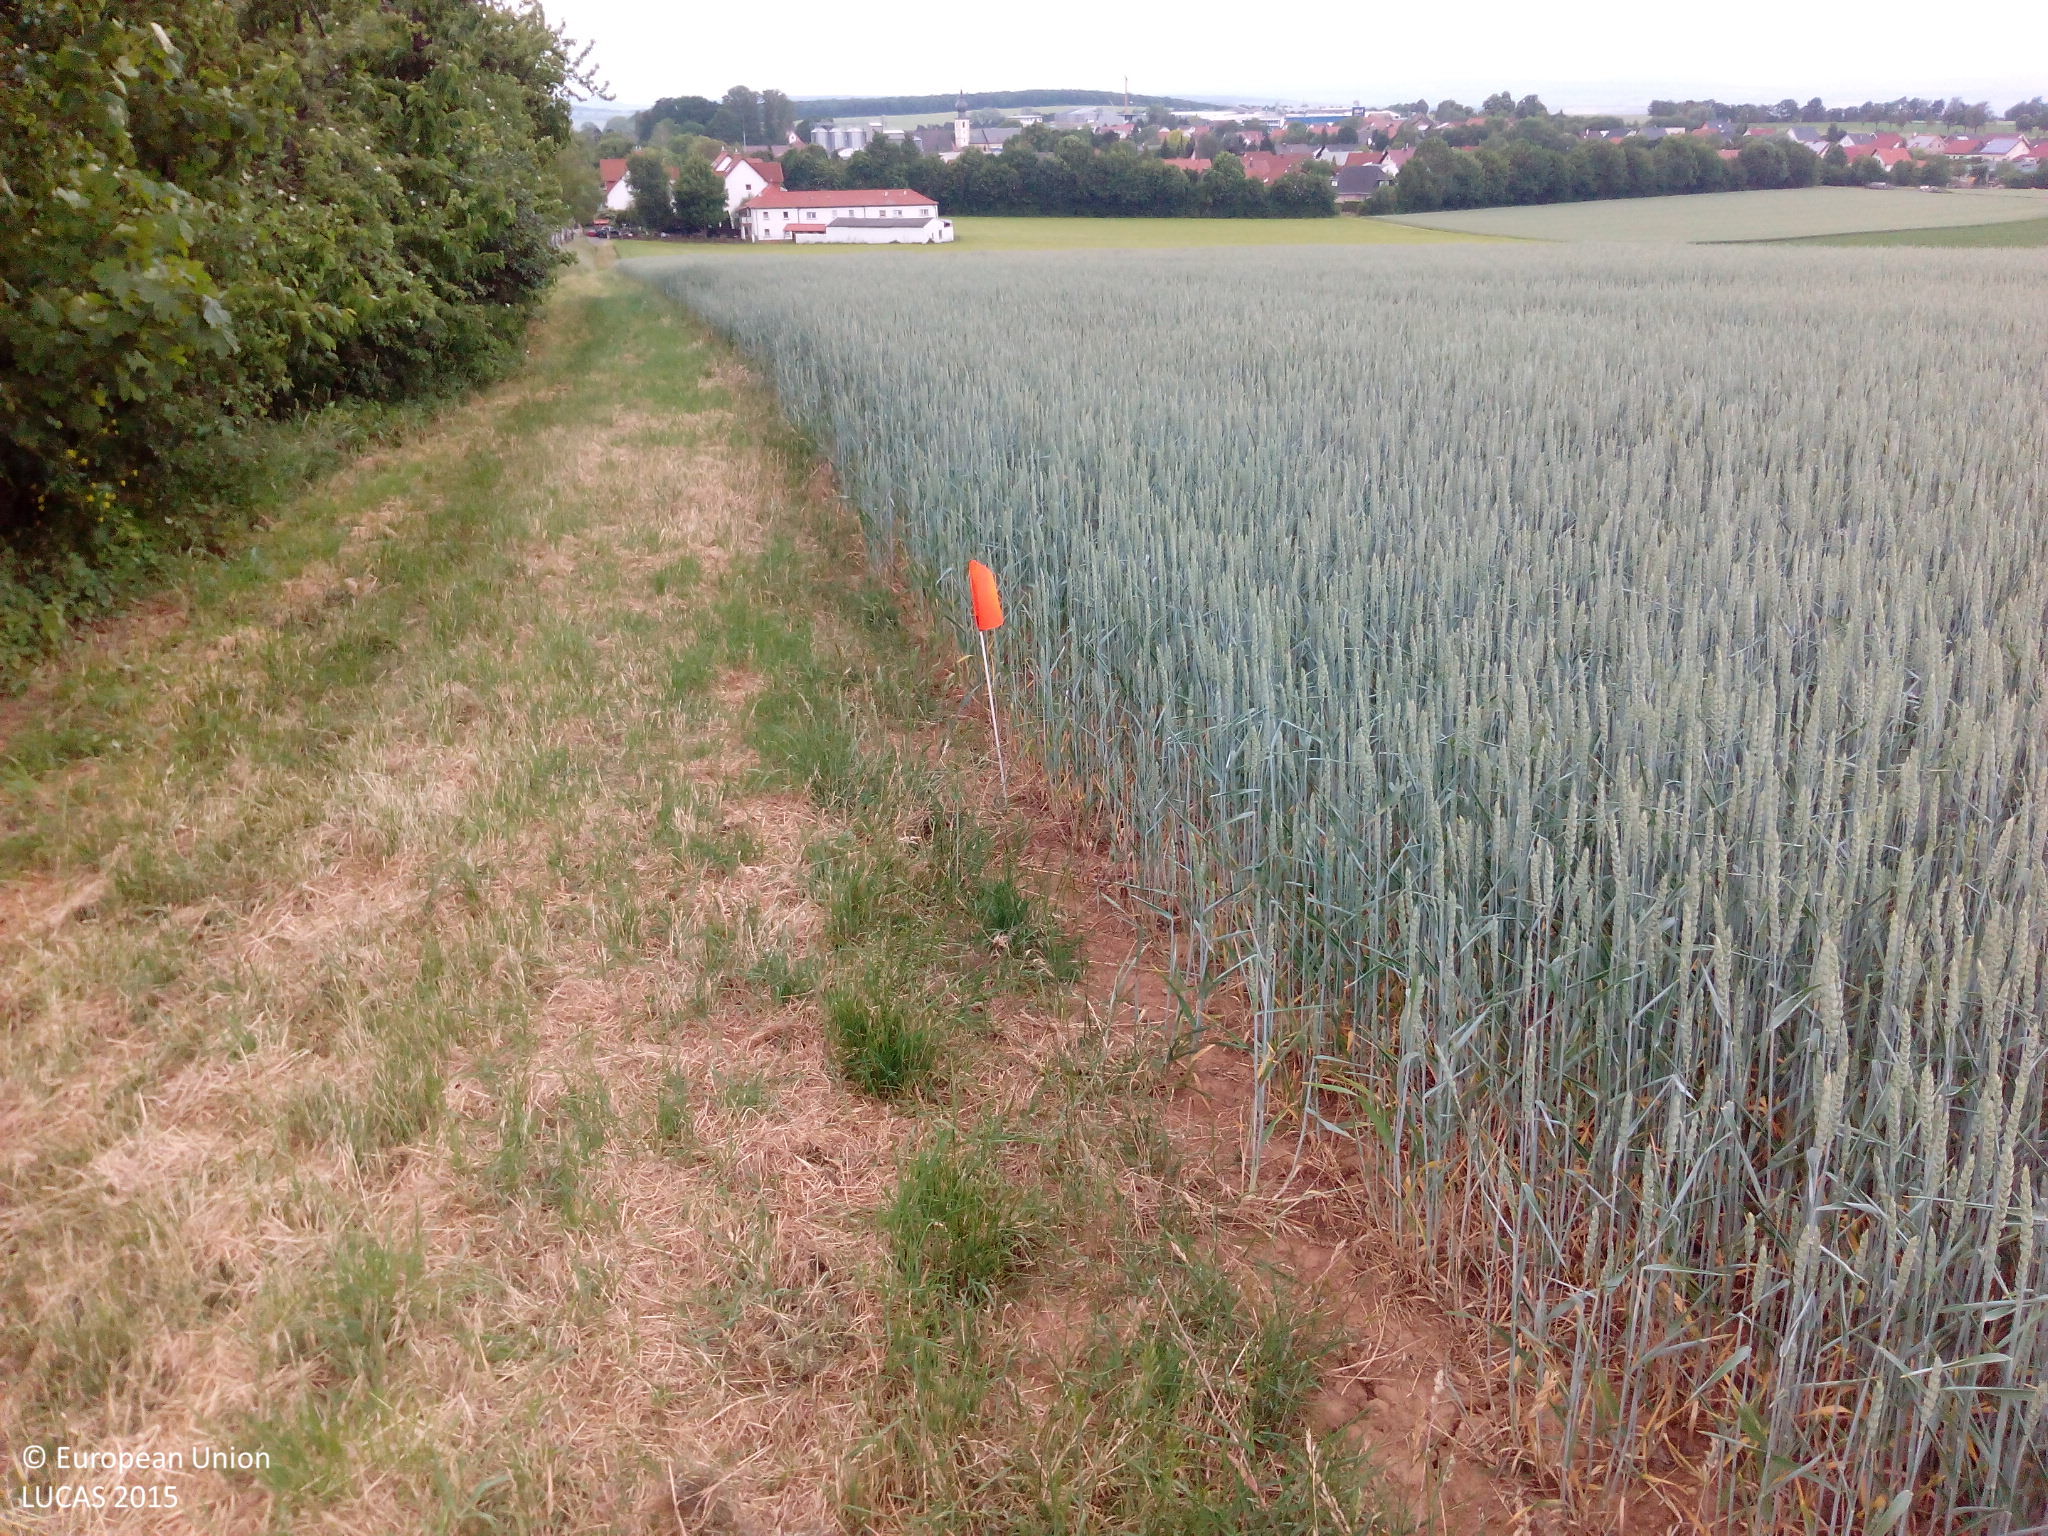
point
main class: Cropland
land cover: Common wheat
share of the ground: > 75 %
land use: Agriculture (excluding fallow land and kitchen gardens)
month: June
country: DE
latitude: 49.7537
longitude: 8.0434
